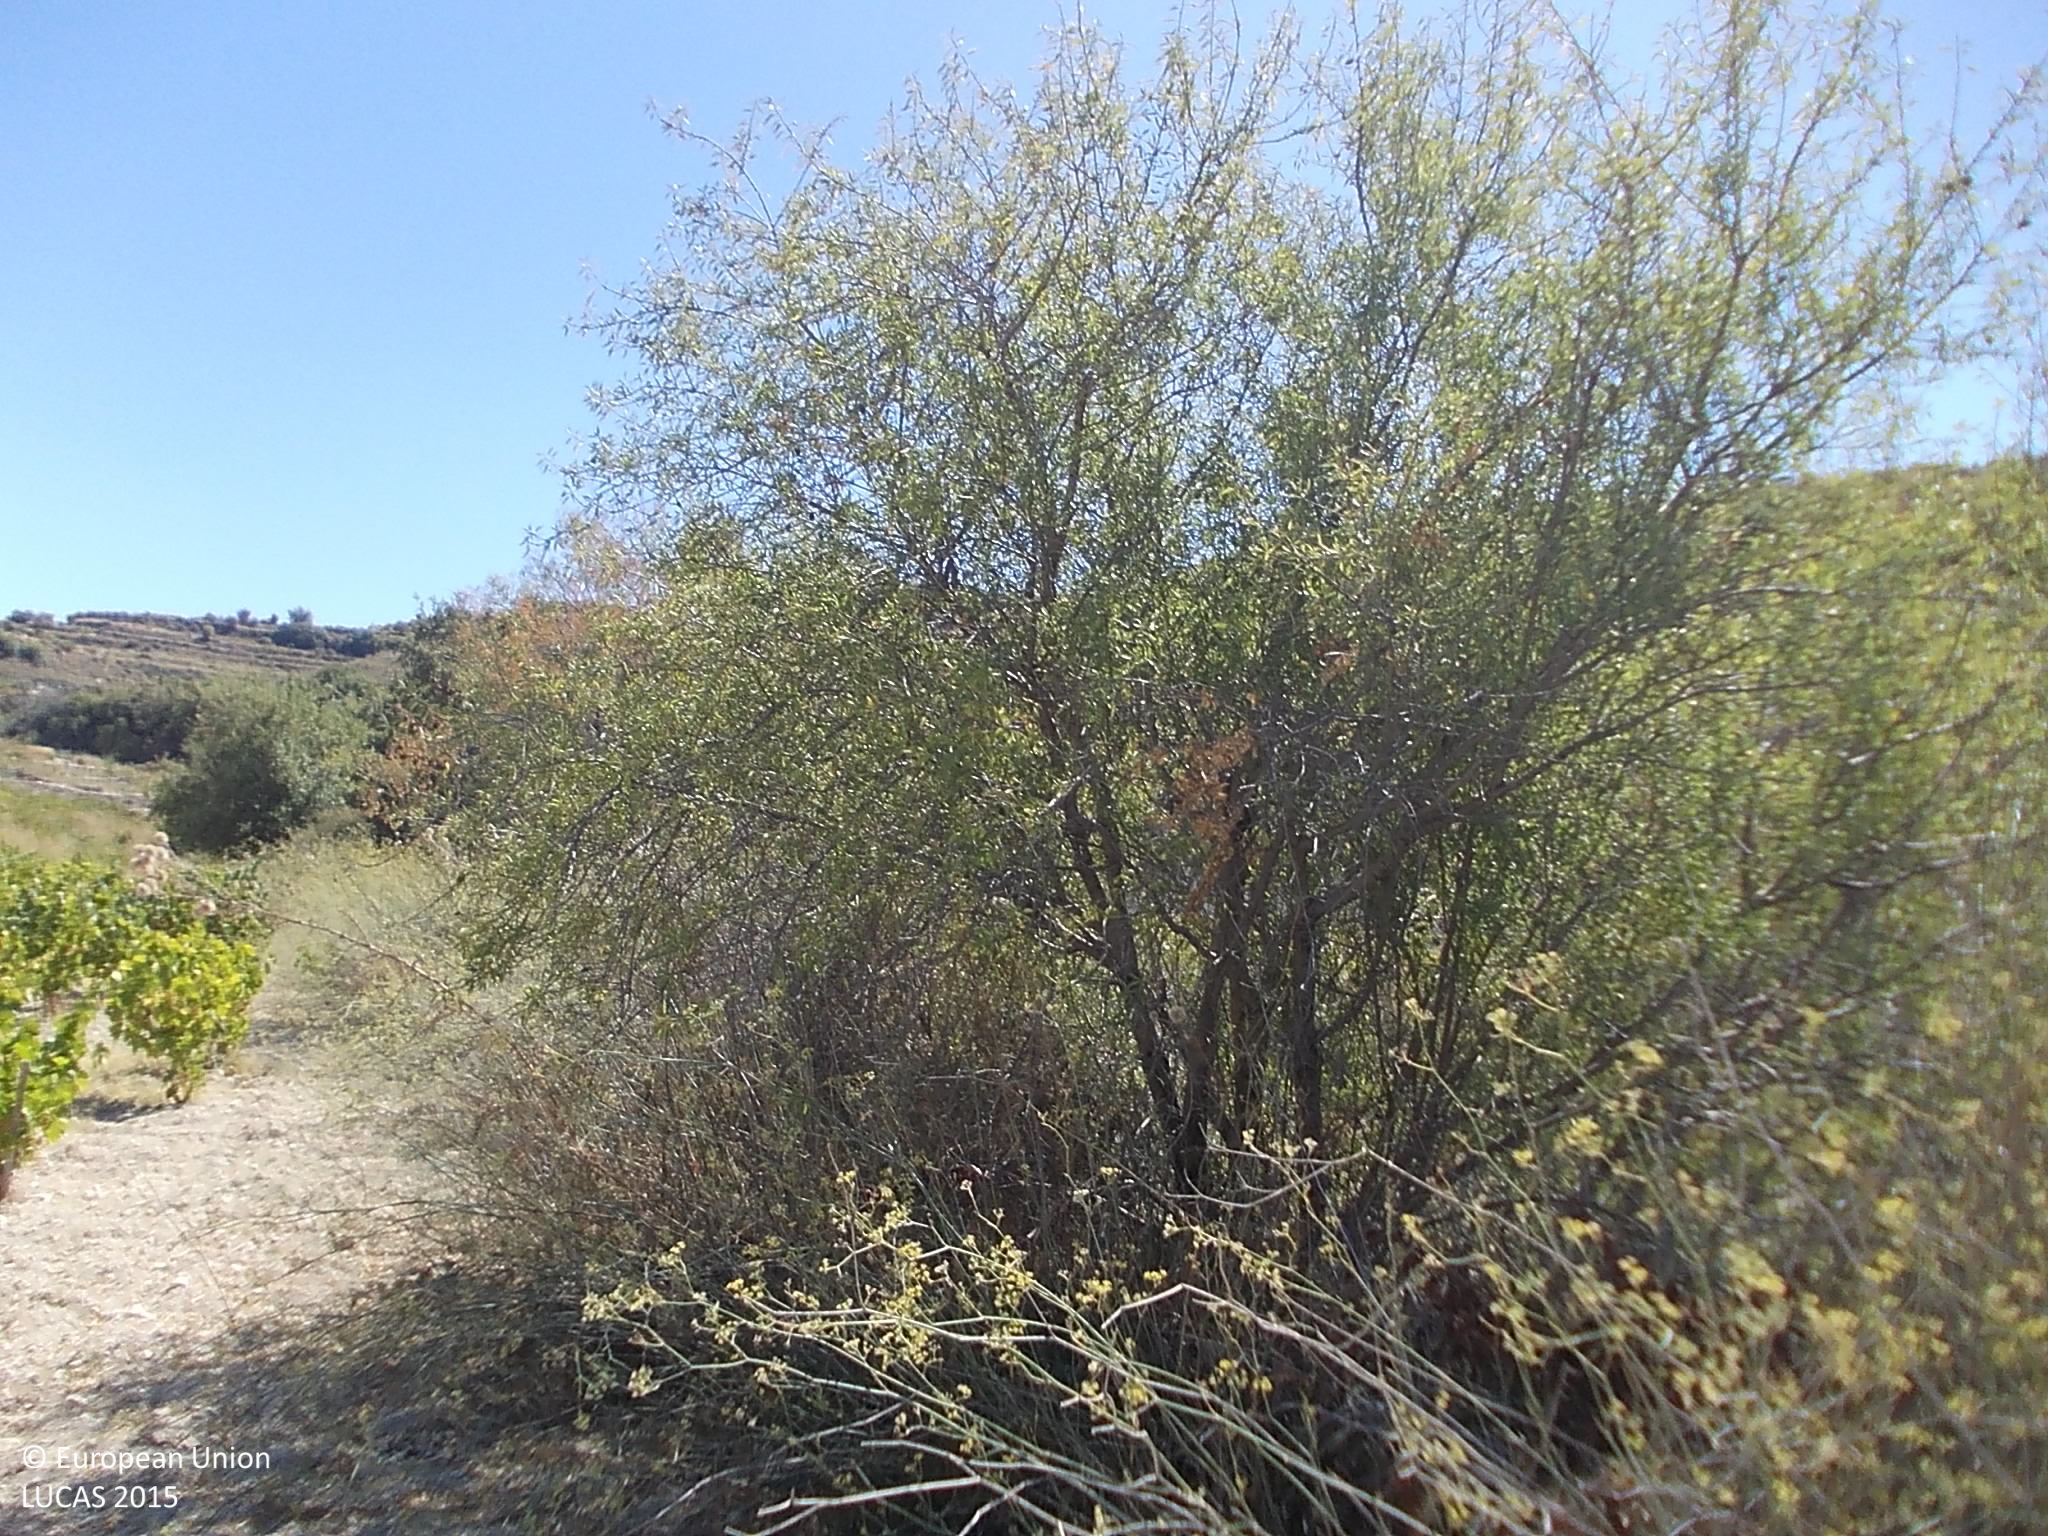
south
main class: Cropland
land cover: Vineyards
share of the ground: 25 - 50 %
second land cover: Other bare soil
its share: > 75 %
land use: Agriculture (excluding fallow land and kitchen gardens)
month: May
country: CY
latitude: 34.7905
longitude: 32.7928
